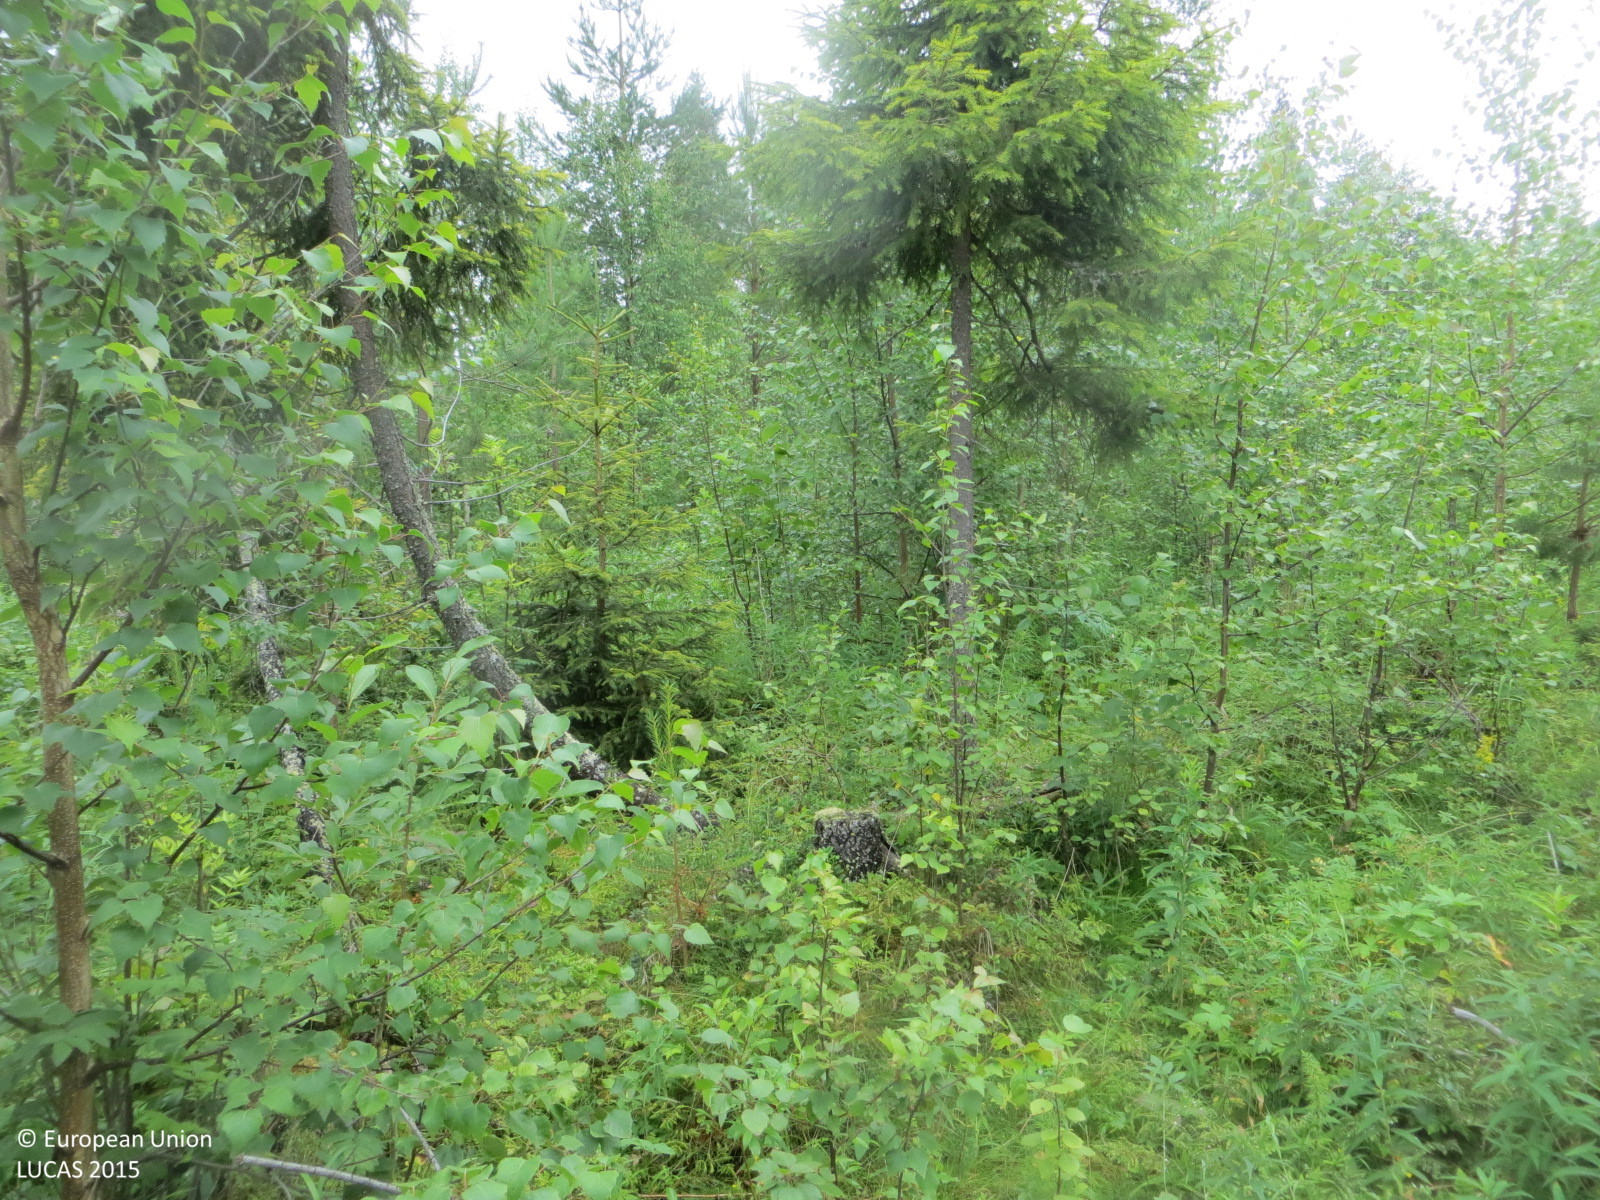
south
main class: Woodland
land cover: Other mixed woodland
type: boreal forest
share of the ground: > 75 %
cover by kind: broadleaved forest trees 50 %, coniferous forest trees 30 %, herbaceous plants 20 %
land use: Forestry
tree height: > 5 m
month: July
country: FI
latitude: 66.1416
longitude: 24.7433
